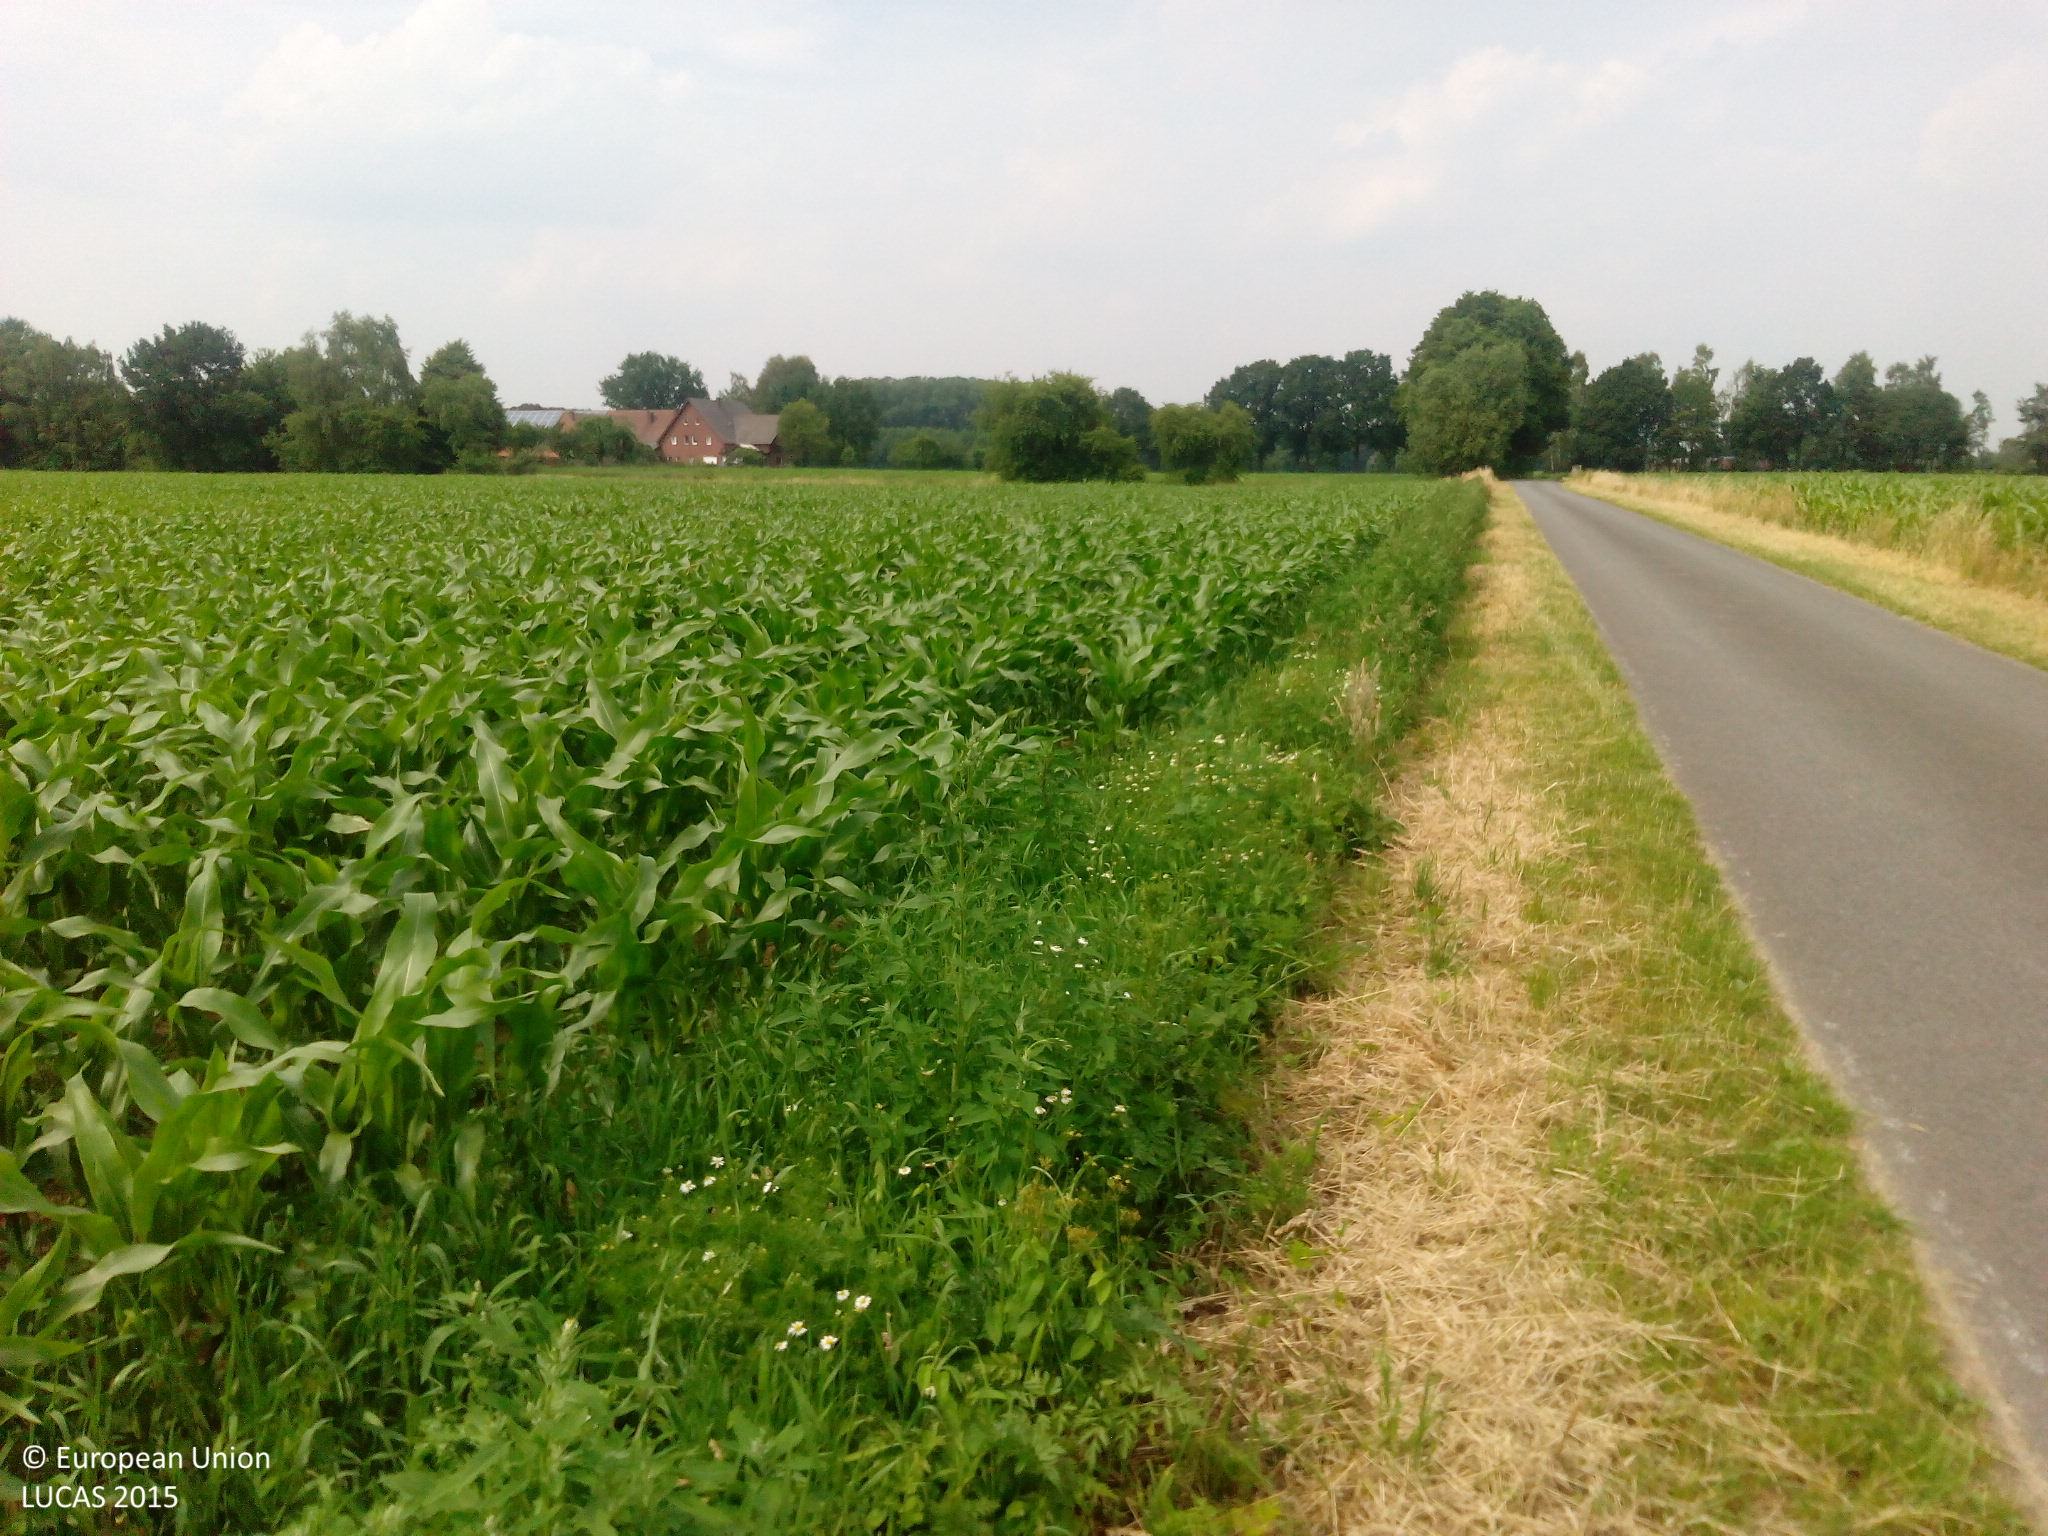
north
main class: Cropland
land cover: Maize
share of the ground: > 75 %
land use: Agriculture (excluding fallow land and kitchen gardens)
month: June
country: DE
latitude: 51.7741
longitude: 8.4497
